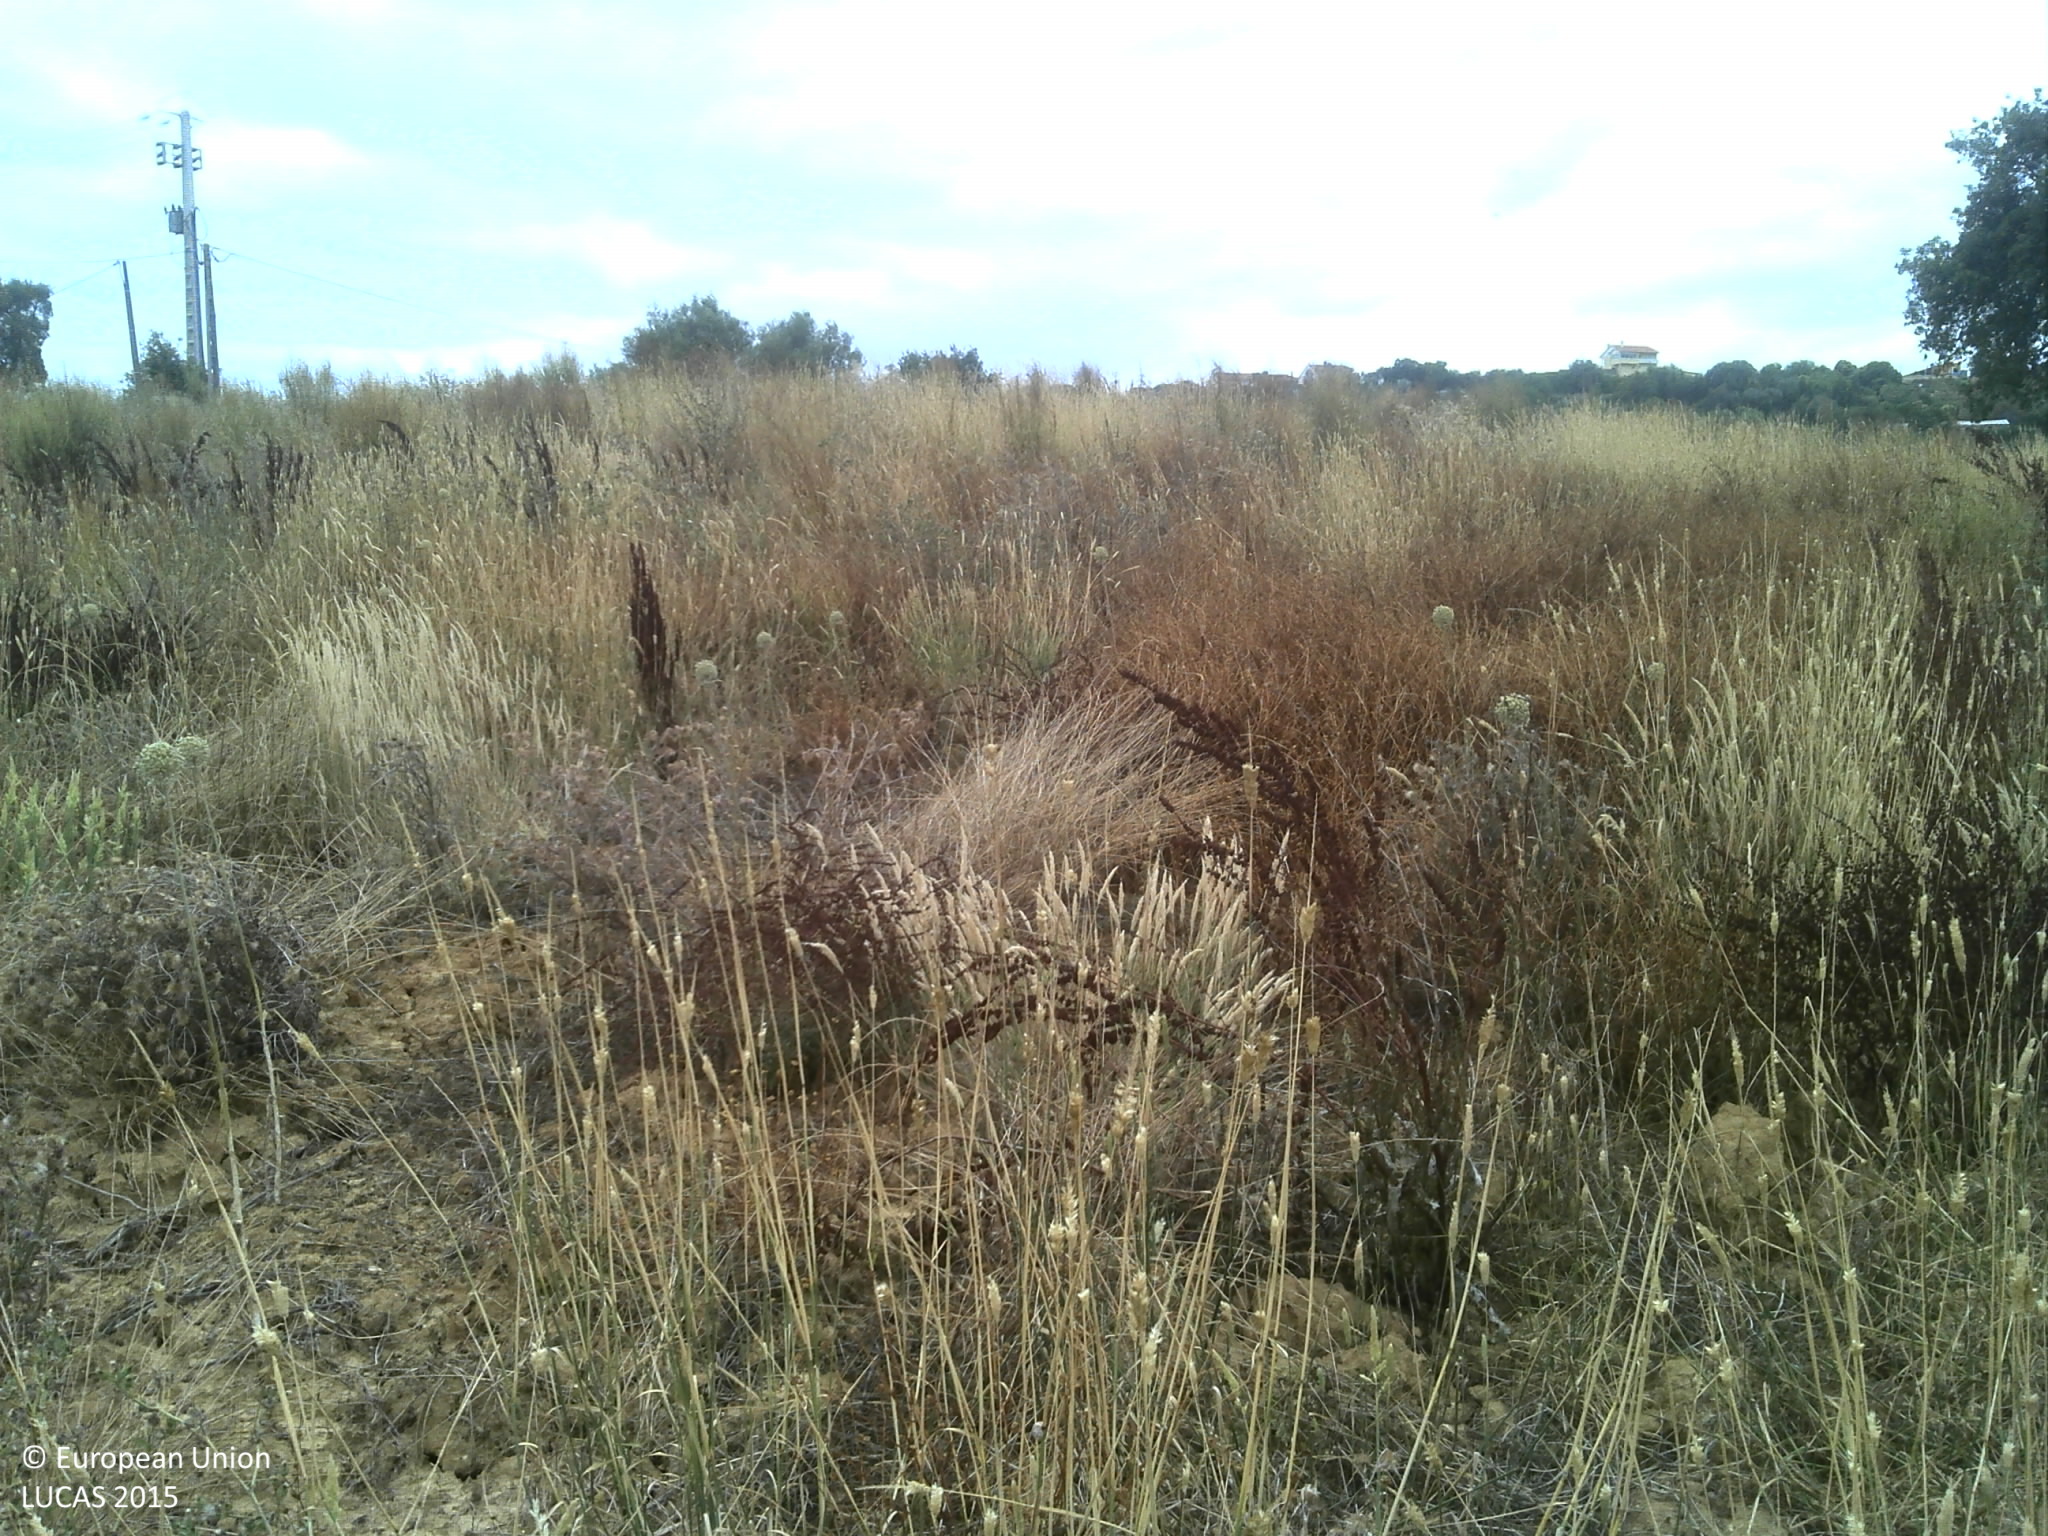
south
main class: Shrubland
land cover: Shrubland without tree cover
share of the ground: 50 - 75 %
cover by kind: shrubs 60 %, unconsolidated bare surface 30 %, herbaceous plants 10 %
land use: Abandoned areas
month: June
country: PT
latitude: 39.2221
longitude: -8.7339
